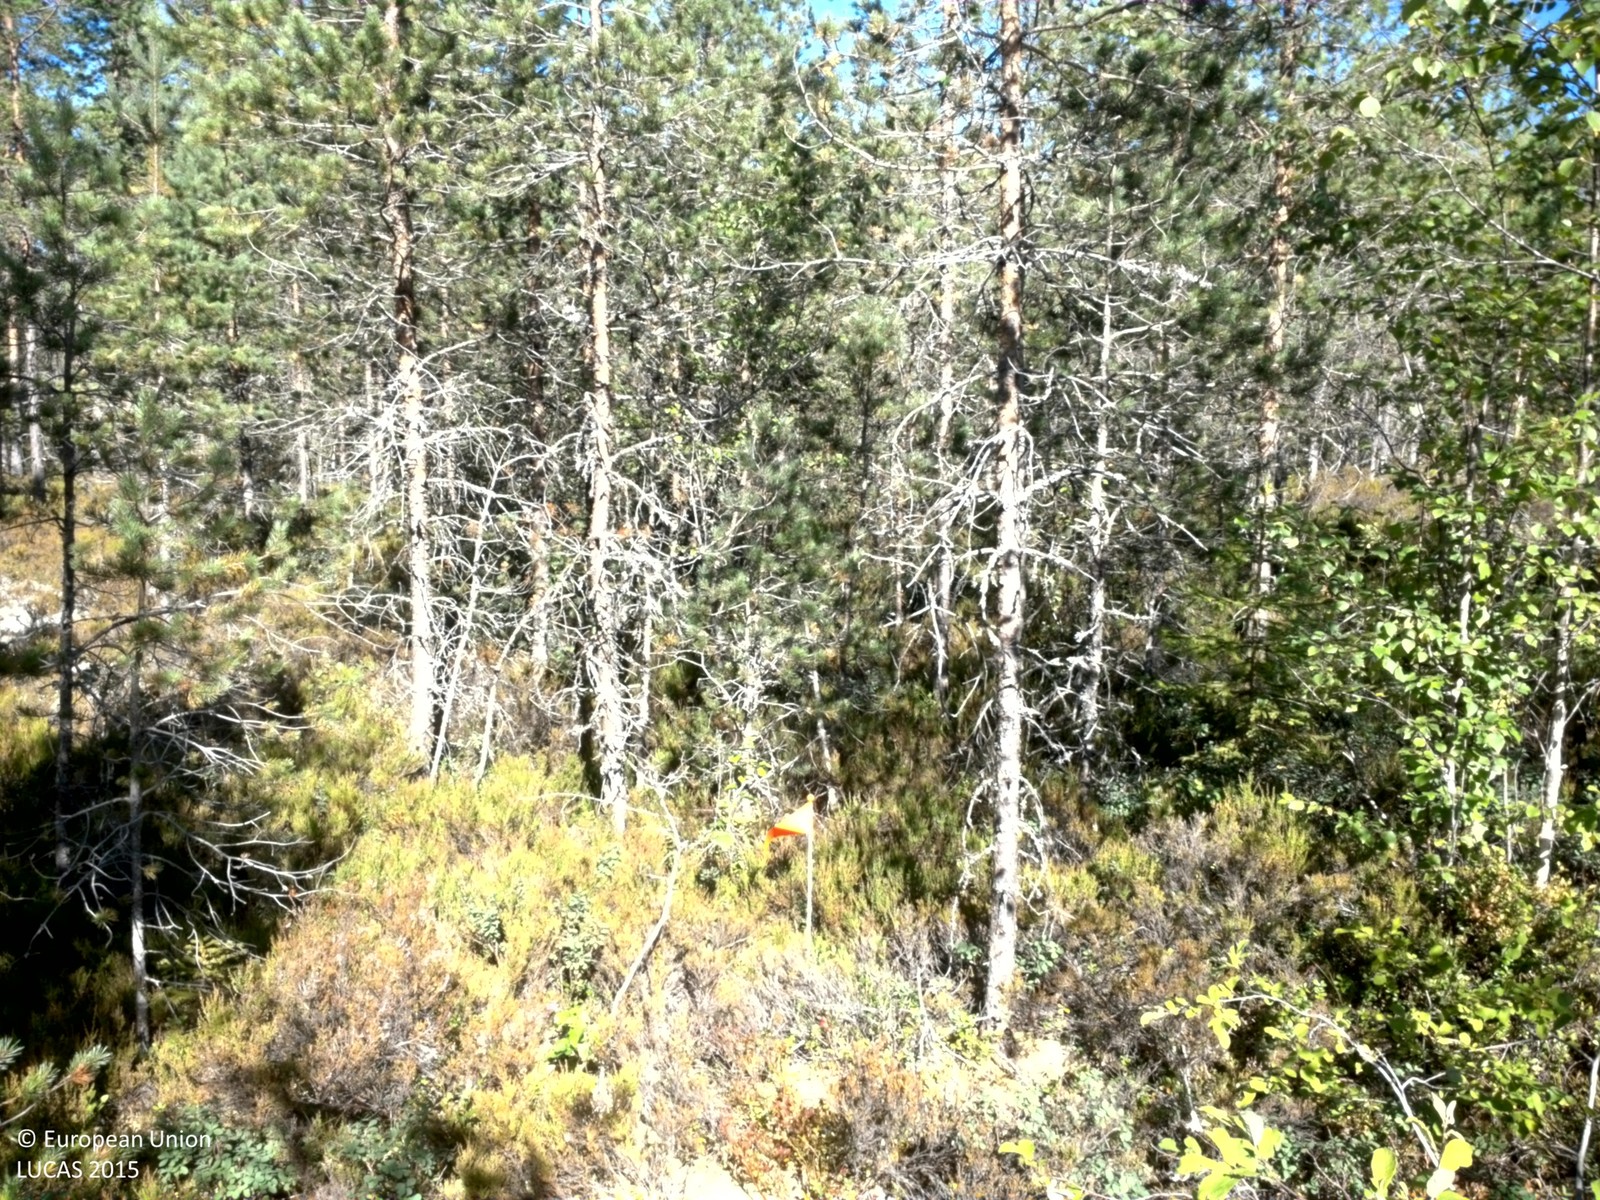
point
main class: Woodland
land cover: Other coniferous woodland
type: boreal forest
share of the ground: 50 - 75 %
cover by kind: coniferous forest trees 60 %, shrubs 30 %, broadleaved forest trees 5 %, lichens and mosses 5 %
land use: Forestry
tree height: > 5 m
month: August
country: SE
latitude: 59.9391
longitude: 14.1601
